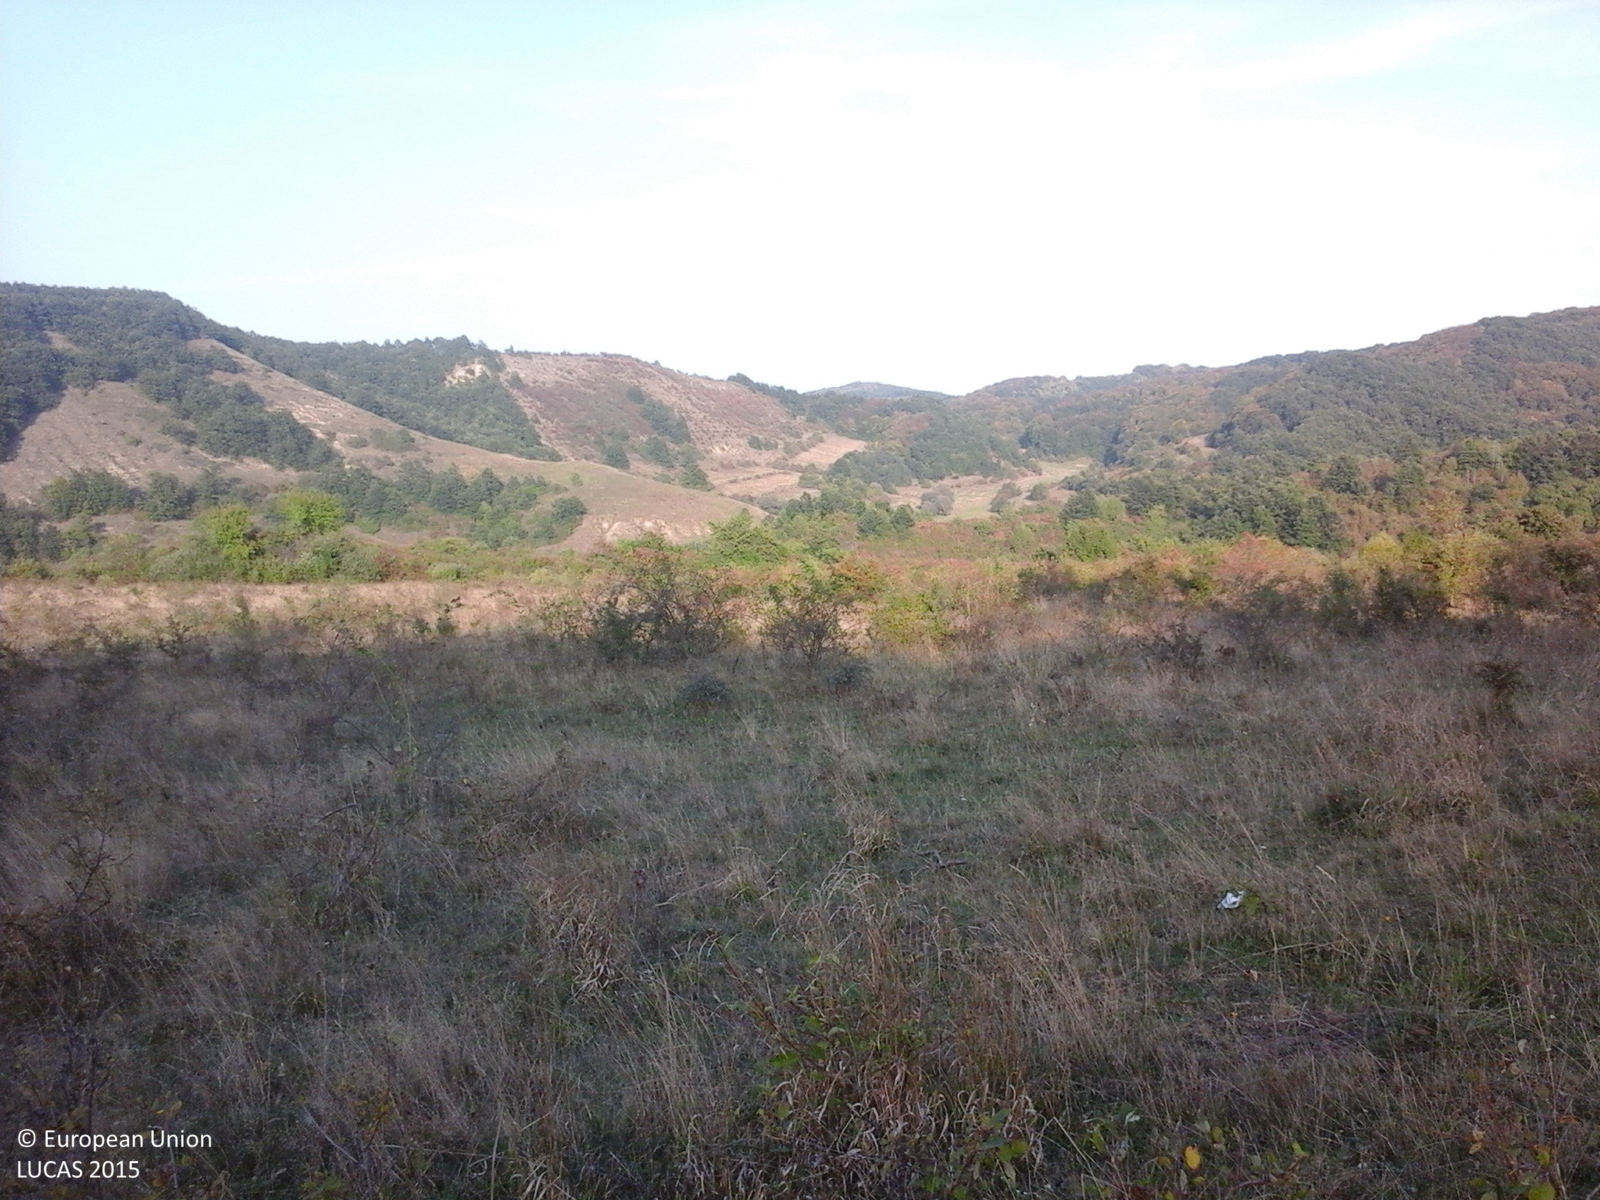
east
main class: Grassland
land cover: Grassland with sparse tree/shrub cover
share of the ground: > 75 %
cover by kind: herbaceous plants 95 %, broadleaved forest trees 5 %
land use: Fallow land
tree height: < 5 m
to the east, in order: Grassland with sparse tree/shrub cover; Shrubland without tree cover; Grassland with sparse tree/shrub cover; Tracks; Shrubland with sparse tree cover
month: September
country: RO
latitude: 46.9975
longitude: 23.4171
